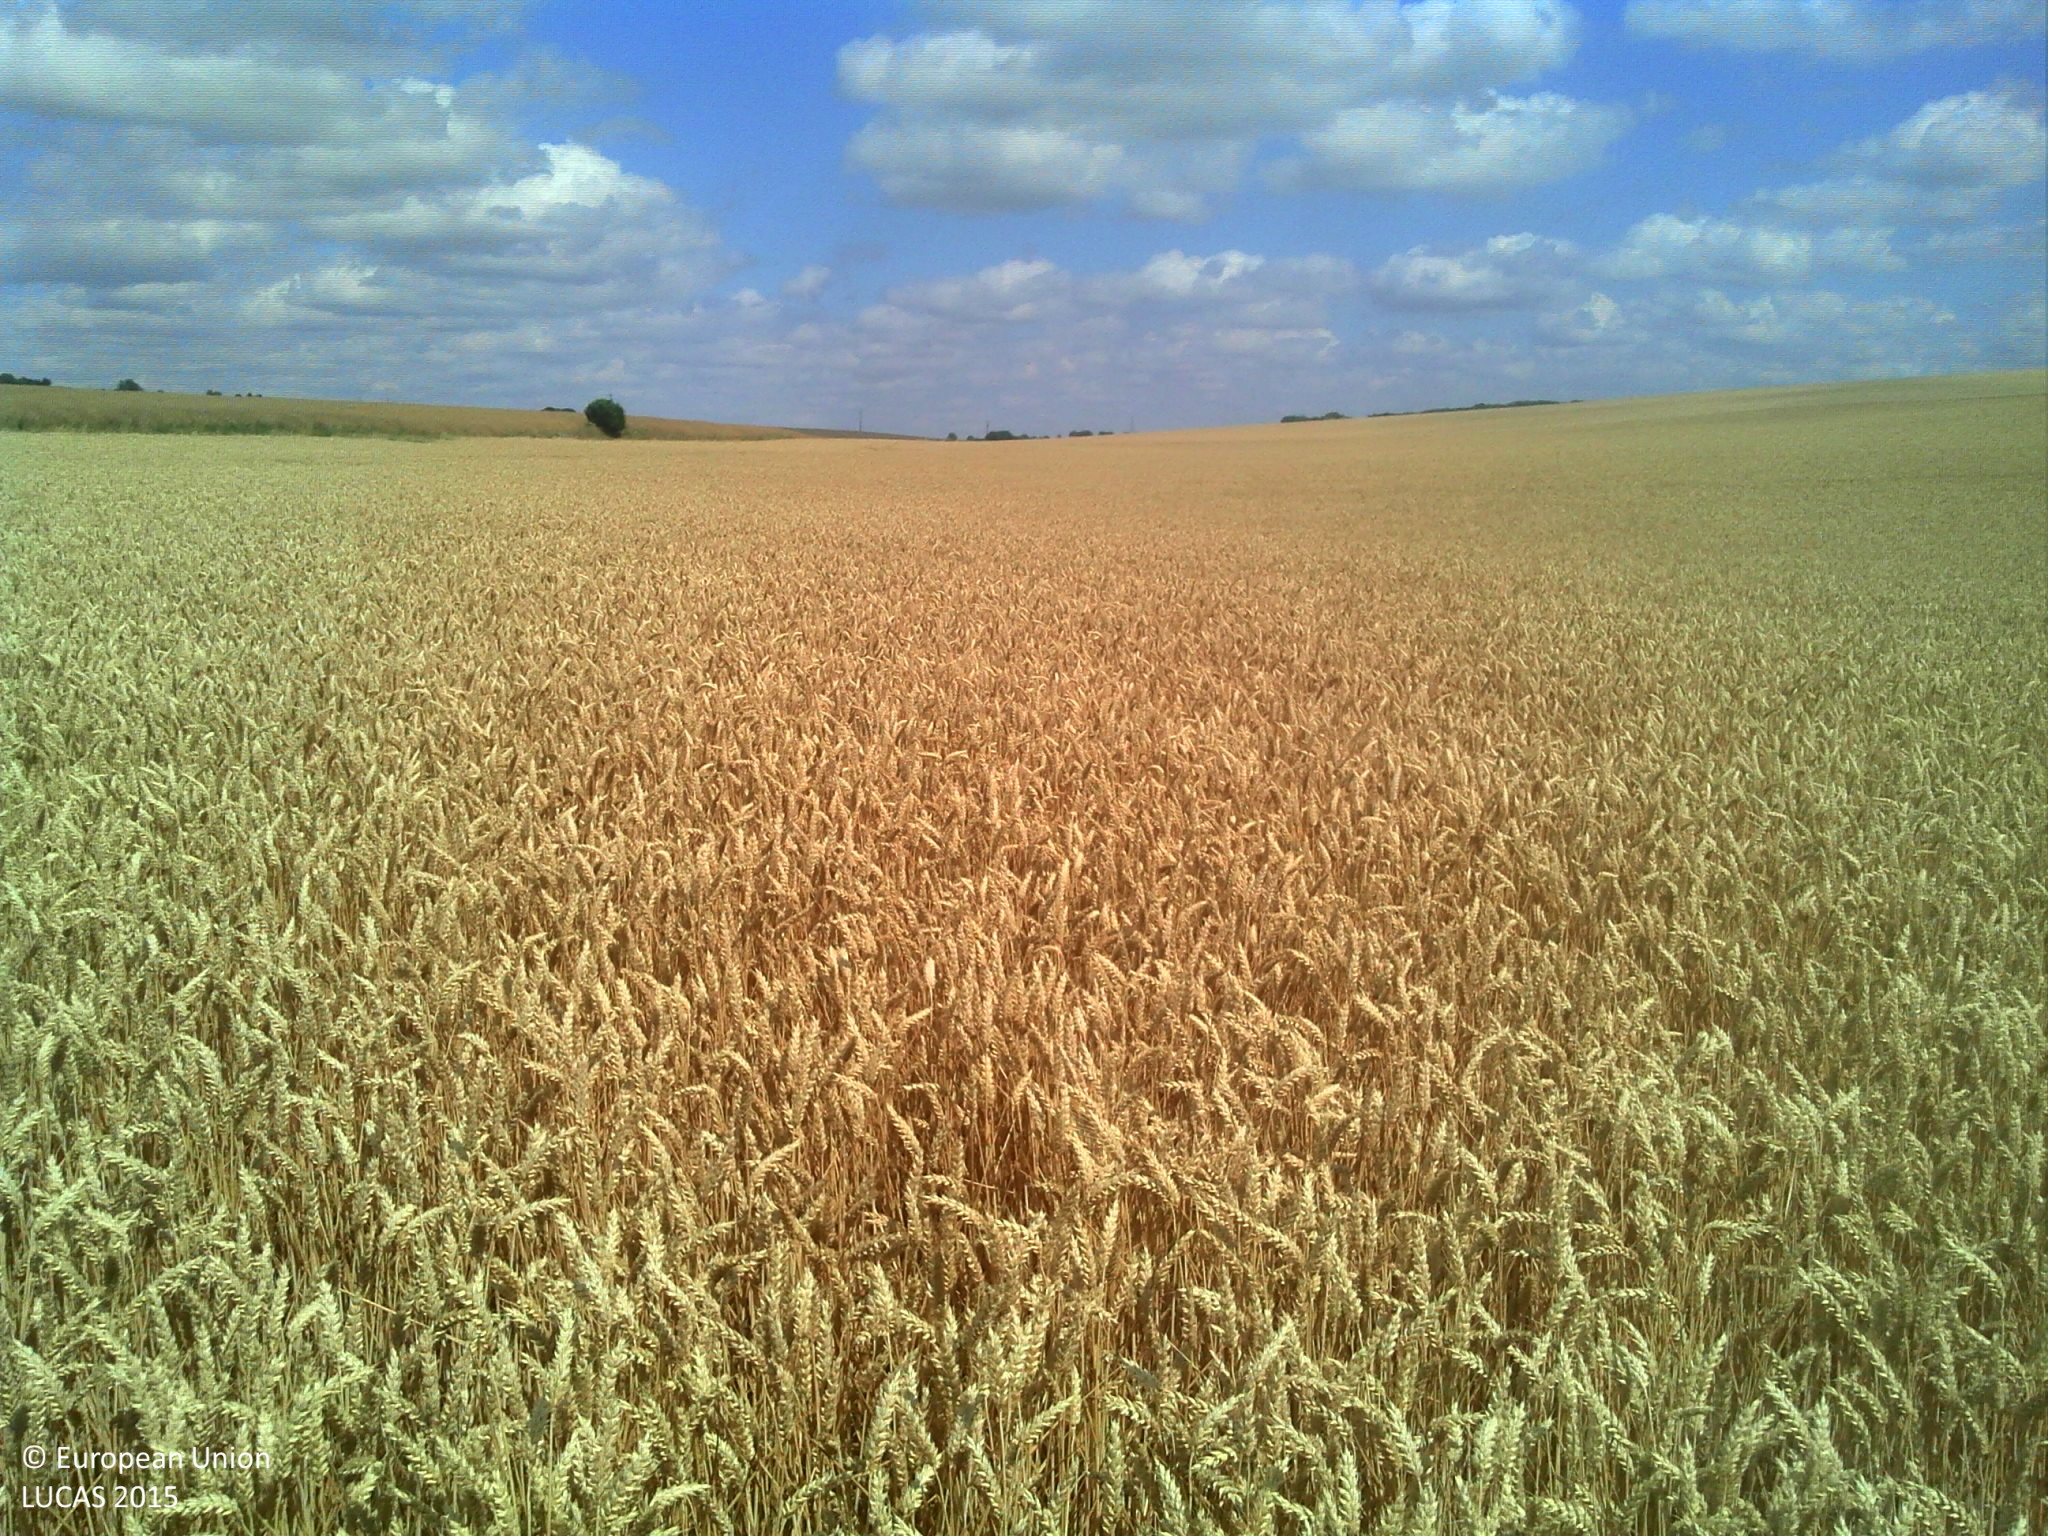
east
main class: Cropland
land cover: Common wheat
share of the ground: > 75 %
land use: Agriculture (excluding fallow land and kitchen gardens)
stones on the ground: < 10 %
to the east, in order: Common wheat
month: July
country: FR
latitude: 49.2669
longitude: 3.3271
